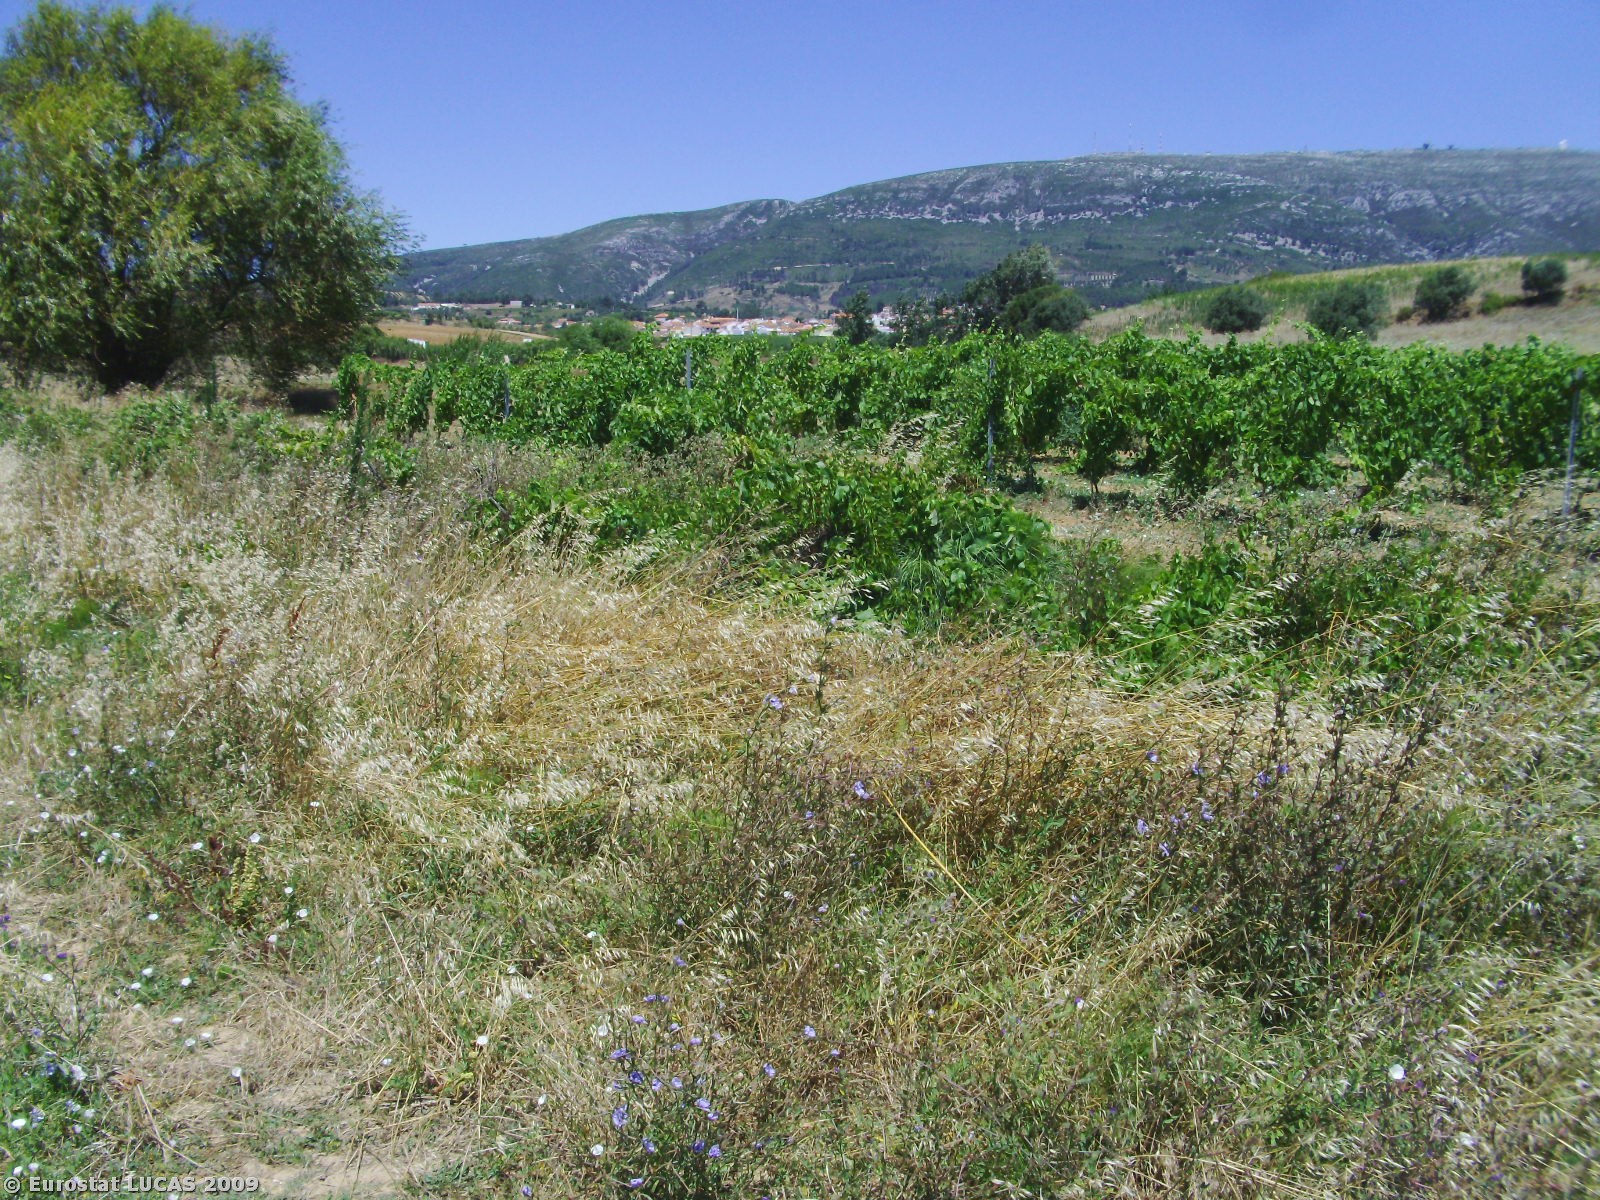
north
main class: Grassland
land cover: Spontaneously vegetated surfaces
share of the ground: 50 - 75 %
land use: Fallow land
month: July
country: PT
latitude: 39.1375
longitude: -9.0664
